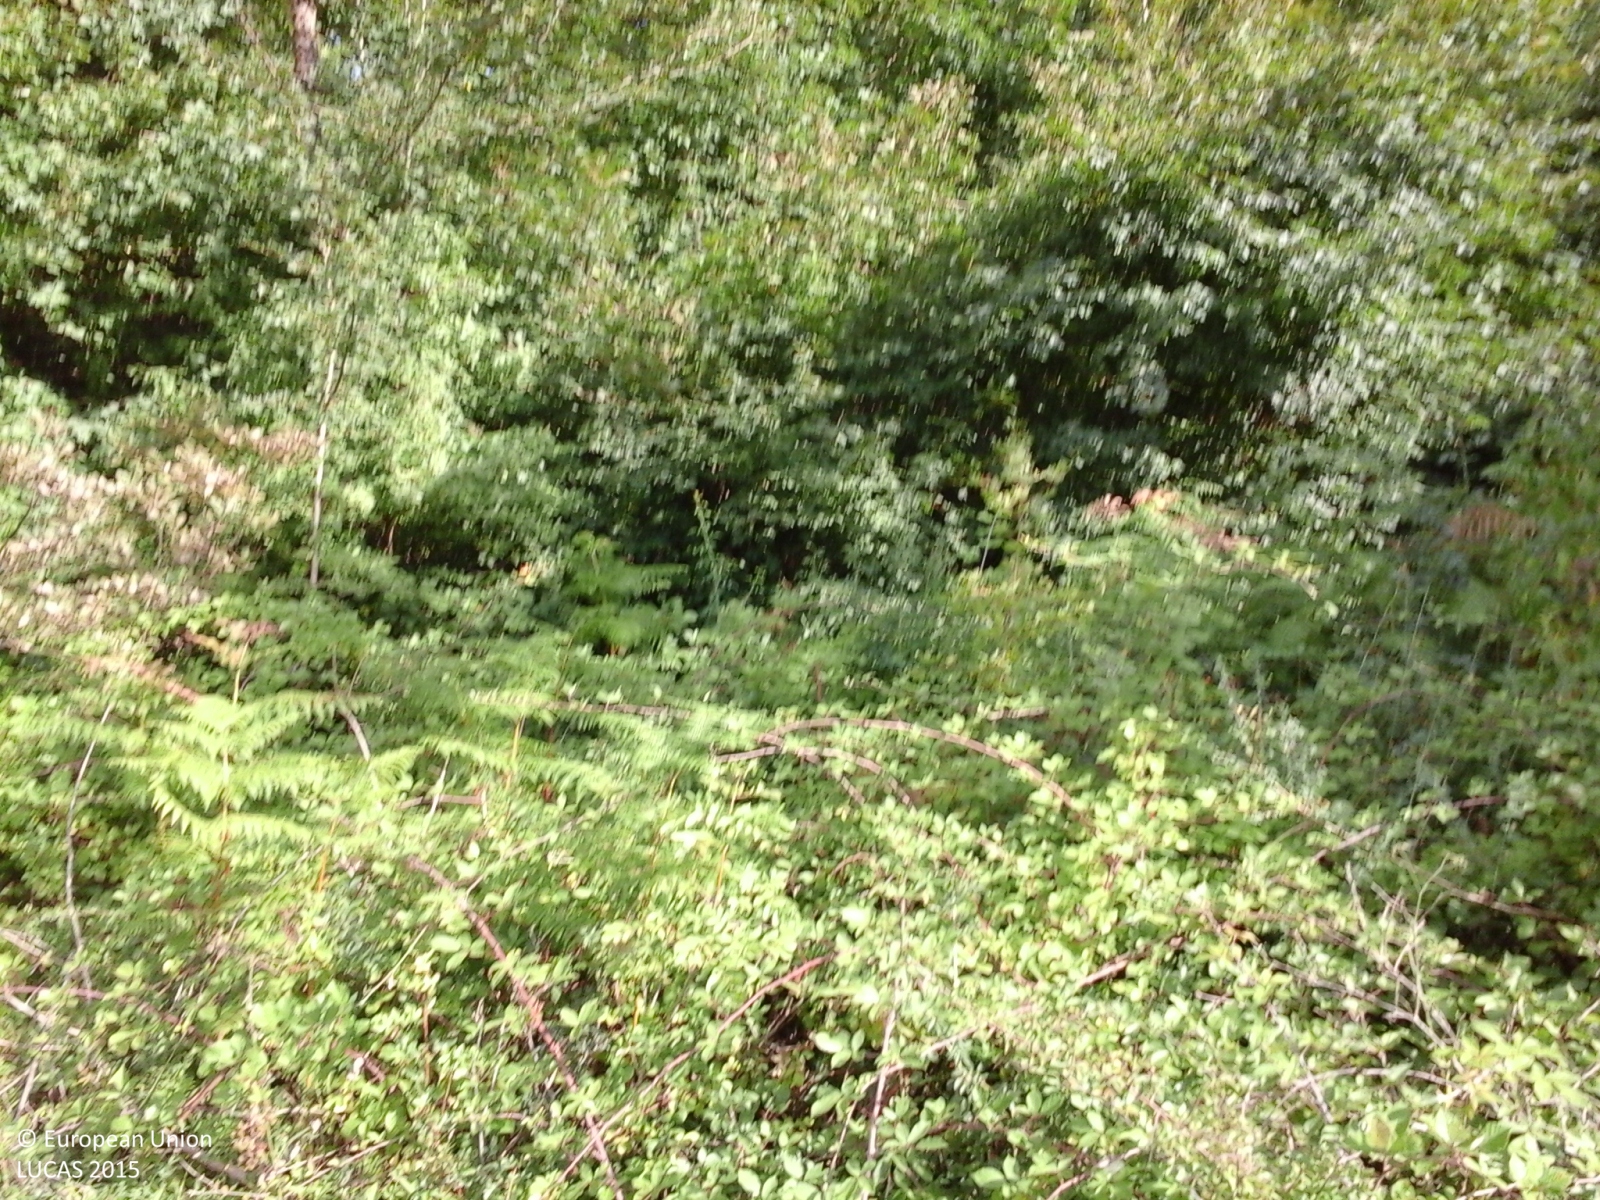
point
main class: Woodland
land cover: Broadleaved woodland
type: thermophilous deciduous forest
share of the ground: > 75 %
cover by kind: broadleaved forest trees 85 %, shrubs 10 %, herbaceous plants 5 %
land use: Semi-natural and natural areas not in use
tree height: > 5 m
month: August
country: IT
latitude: 41.5681
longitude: 14.2897
